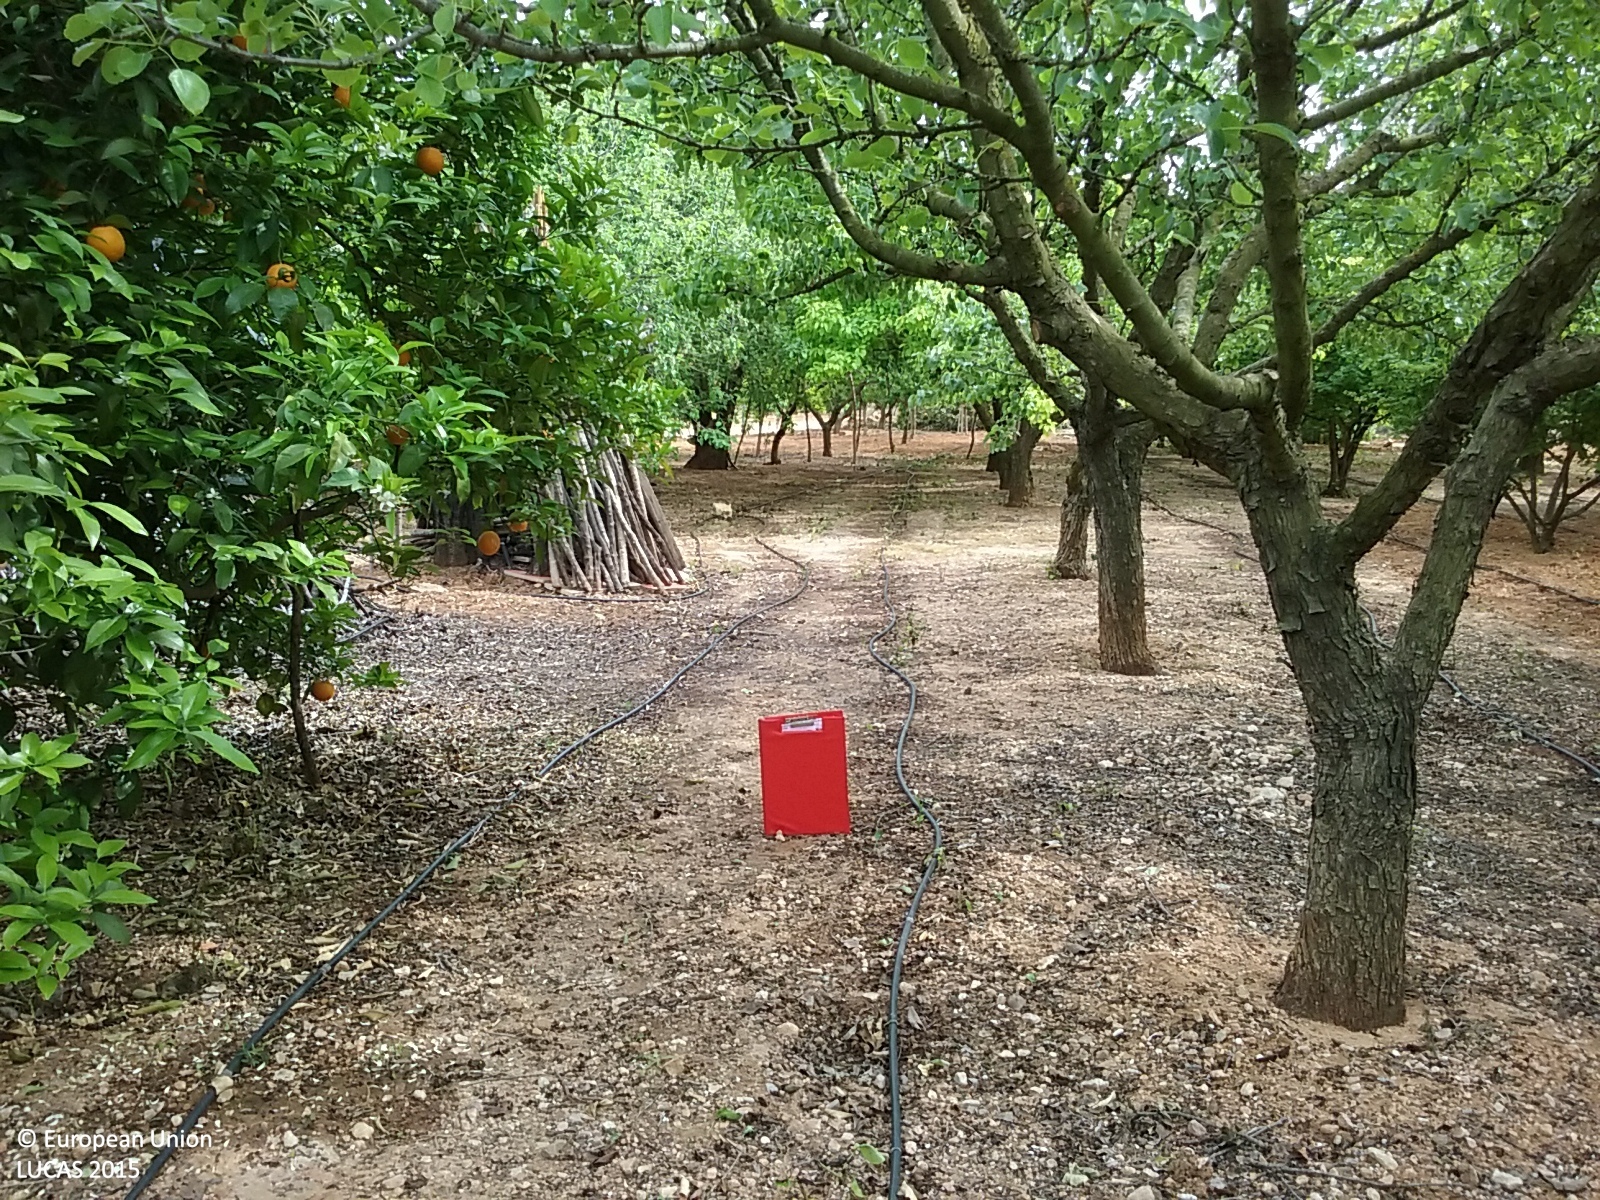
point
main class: Cropland
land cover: Cherry fruit
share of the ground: > 75 %
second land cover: Other bare soil
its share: > 75 %
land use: Agriculture (excluding fallow land and kitchen gardens)
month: May
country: ES
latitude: 40.4451
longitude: 0.3402
